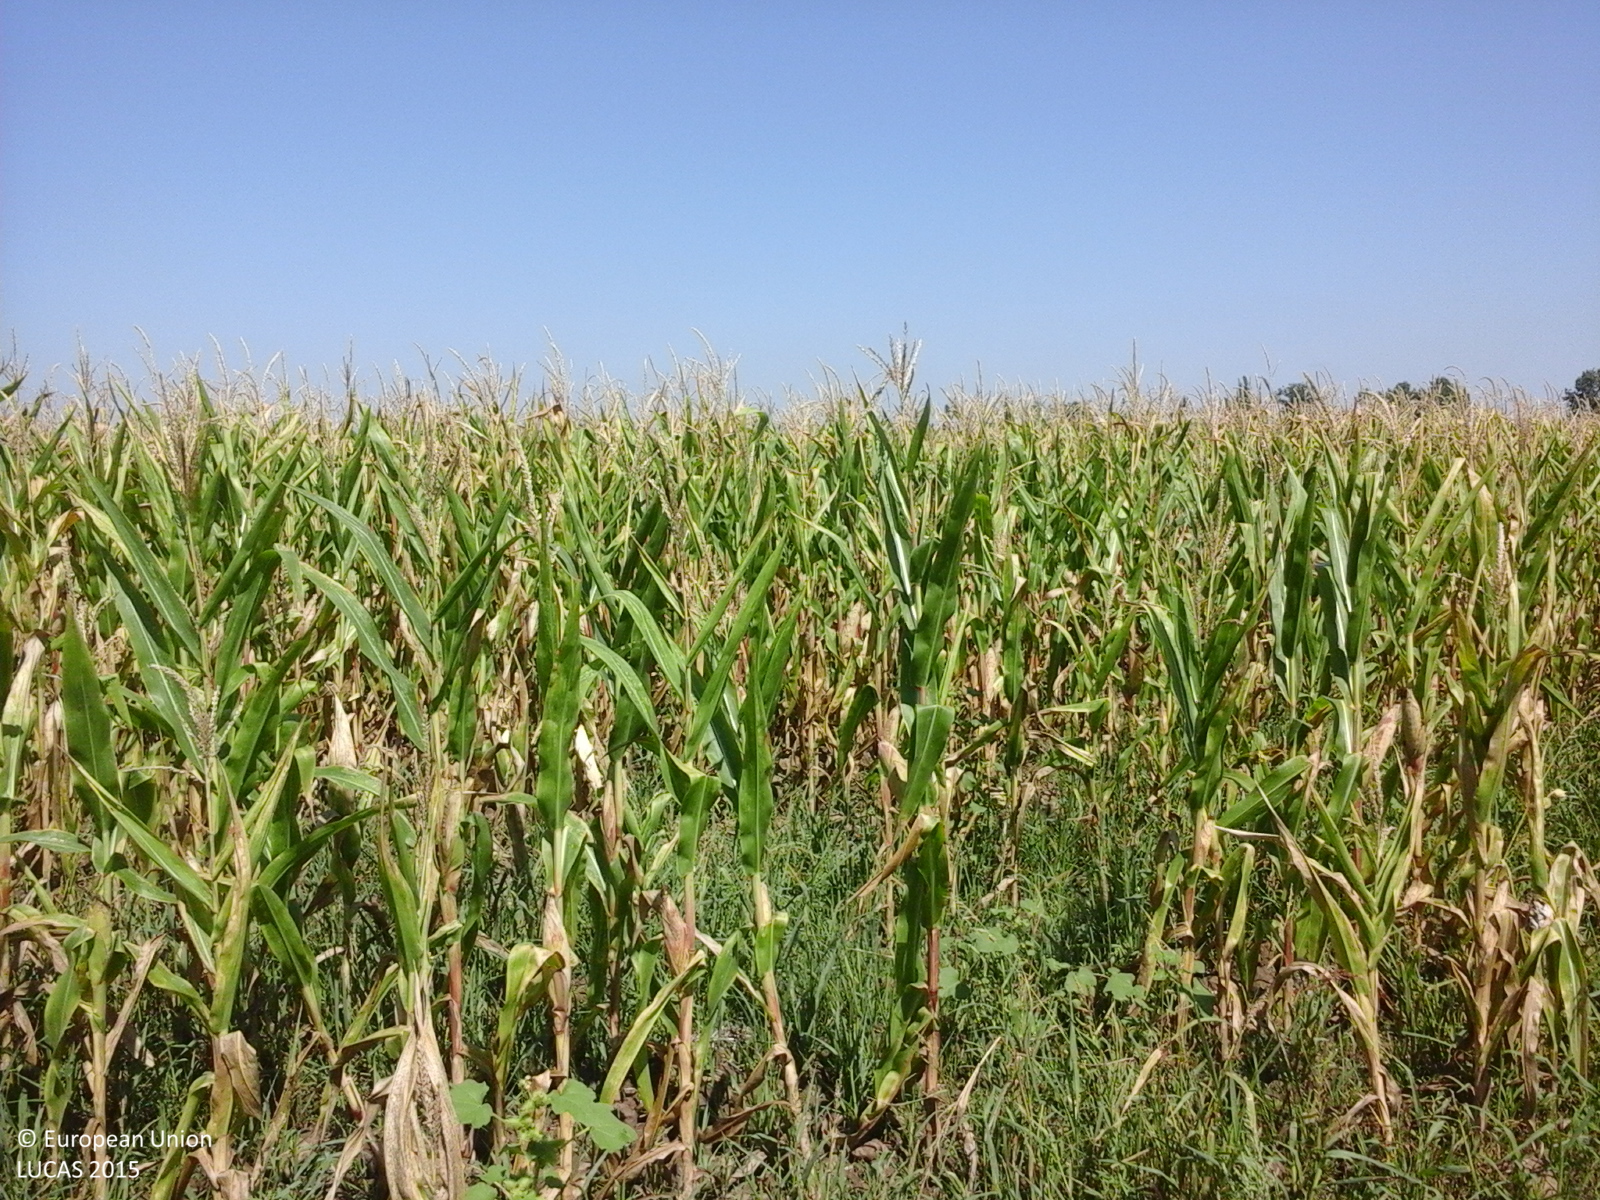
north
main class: Cropland
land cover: Maize
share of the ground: > 75 %
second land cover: Spontaneously vegetated surfaces
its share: > 75 %
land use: Agriculture (excluding fallow land and kitchen gardens)
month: August
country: RO
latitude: 45.6362
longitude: 21.1774
